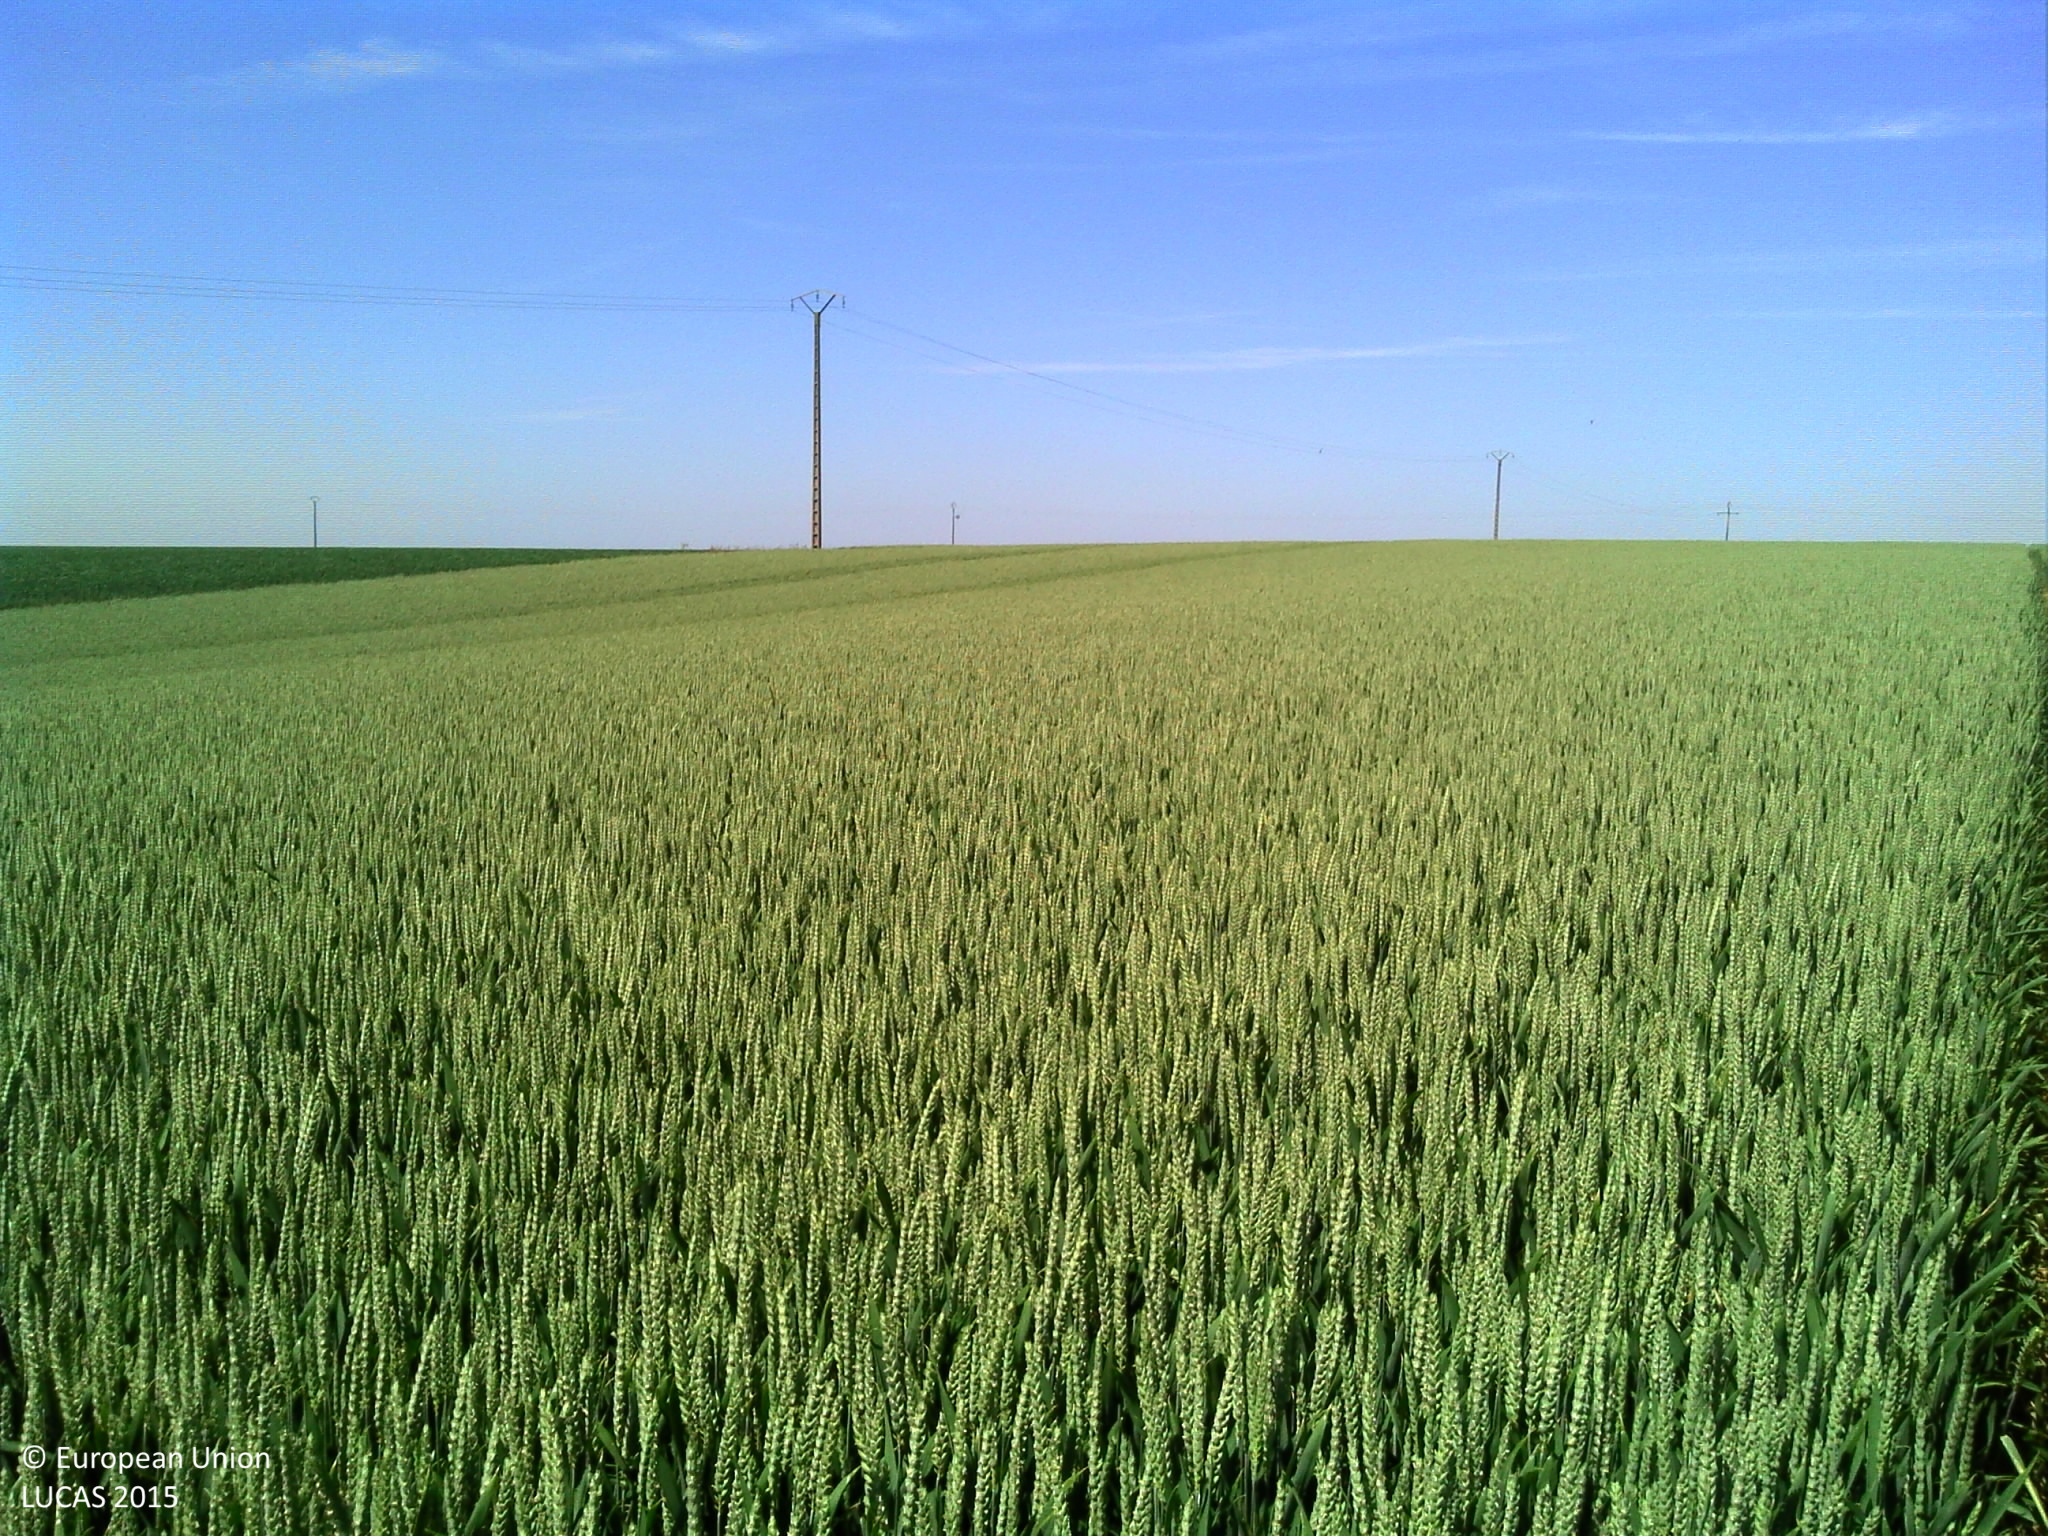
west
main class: Cropland
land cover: Common wheat
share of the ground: > 75 %
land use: Agriculture (excluding fallow land and kitchen gardens)
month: June
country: FR
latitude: 49.4247
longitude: 3.2501
